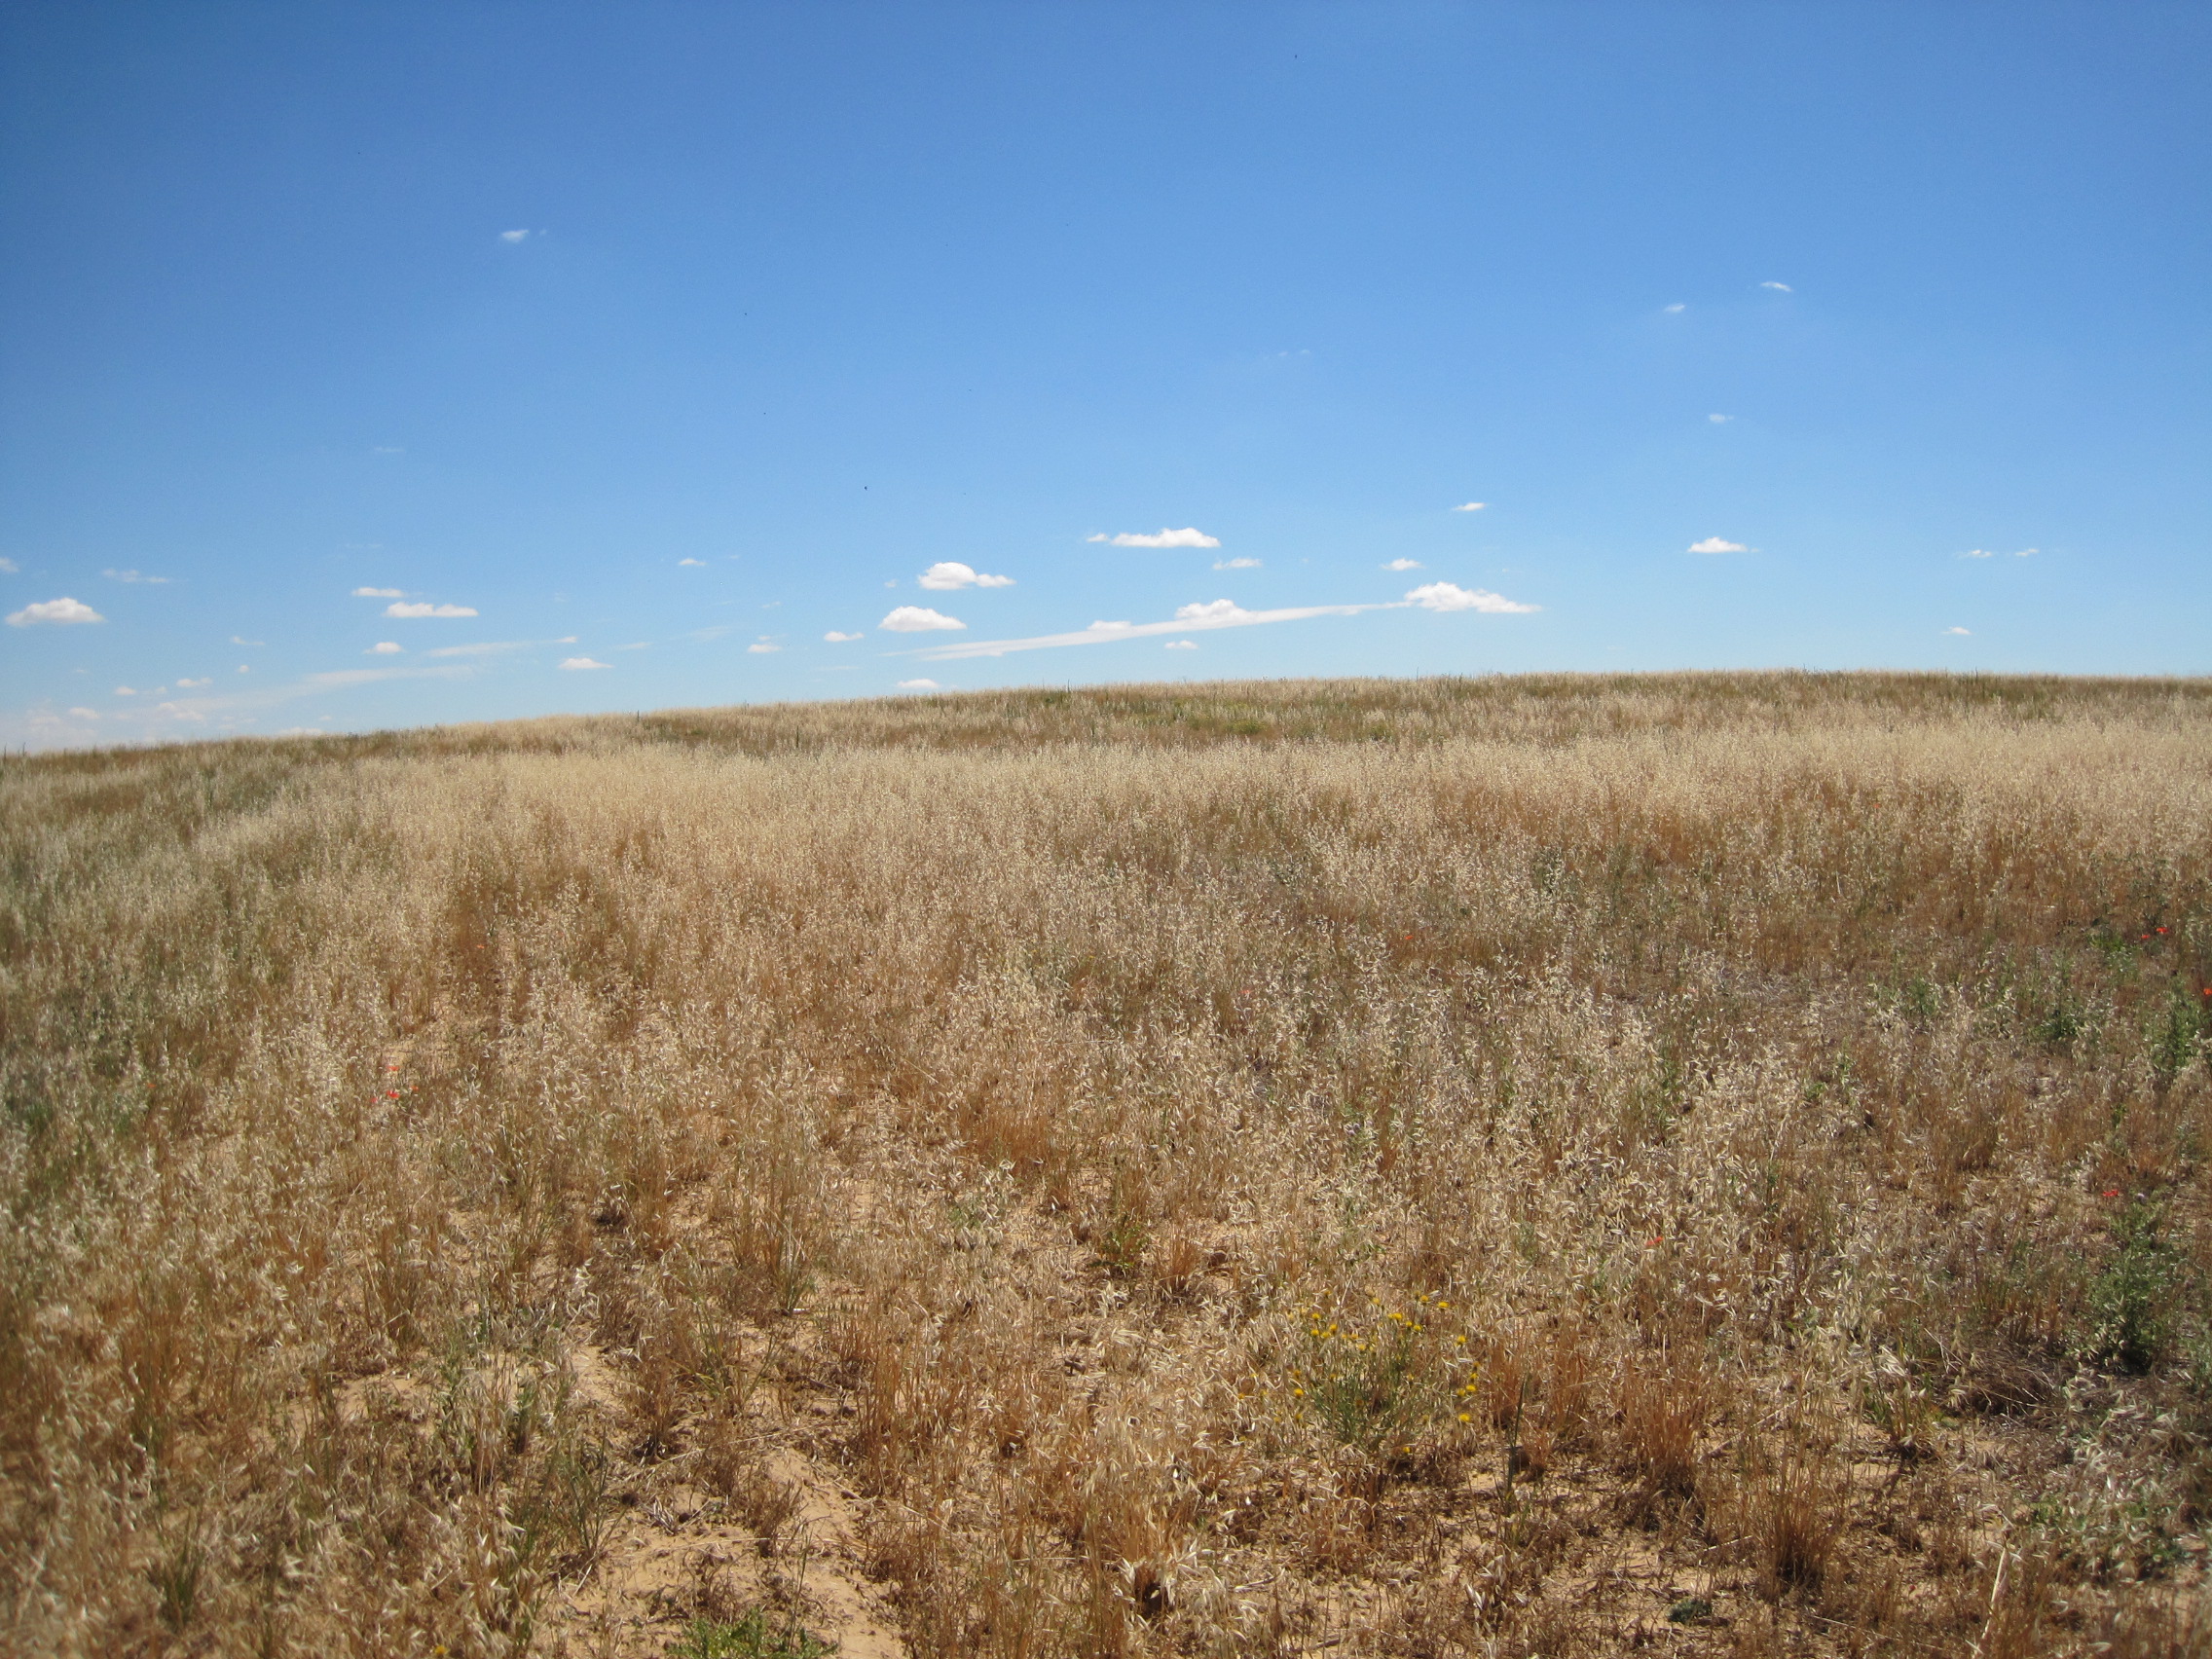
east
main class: Grassland
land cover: Spontaneously vegetated surfaces
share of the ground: > 75 %
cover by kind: herbaceous plants 90 %, unconsolidated bare surface 10 %
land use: Agriculture (excluding fallow land and kitchen gardens)
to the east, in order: Spontaneously vegetated surfaces; Grass margins; Tracks
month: July
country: ES
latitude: 41.9772
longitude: -5.5485
